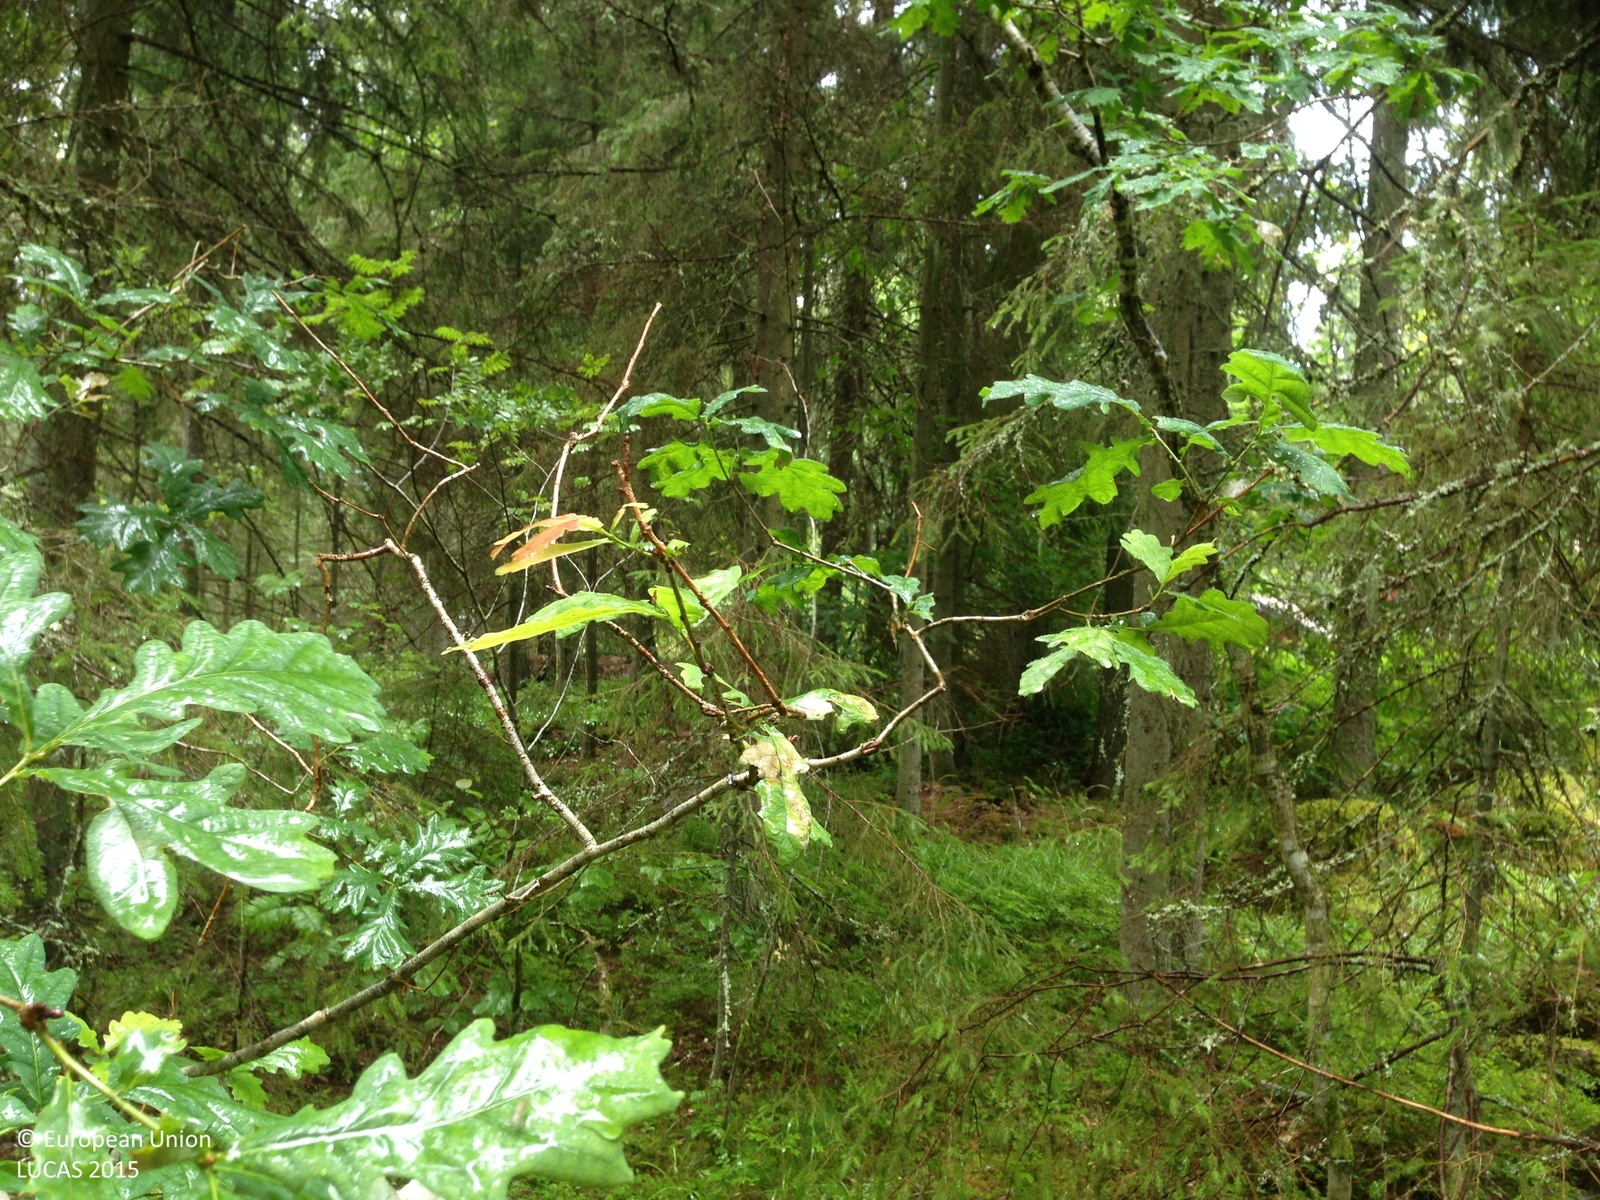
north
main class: Woodland
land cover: Spruce dominated coniferous woodland
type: boreal forest
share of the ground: > 75 %
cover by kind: coniferous forest trees 75 %, lichens and mosses 15 %, broadleaved forest trees 10 %
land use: Forestry
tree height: > 5 m
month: July
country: SE
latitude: 59.9334
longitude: 18.6416
